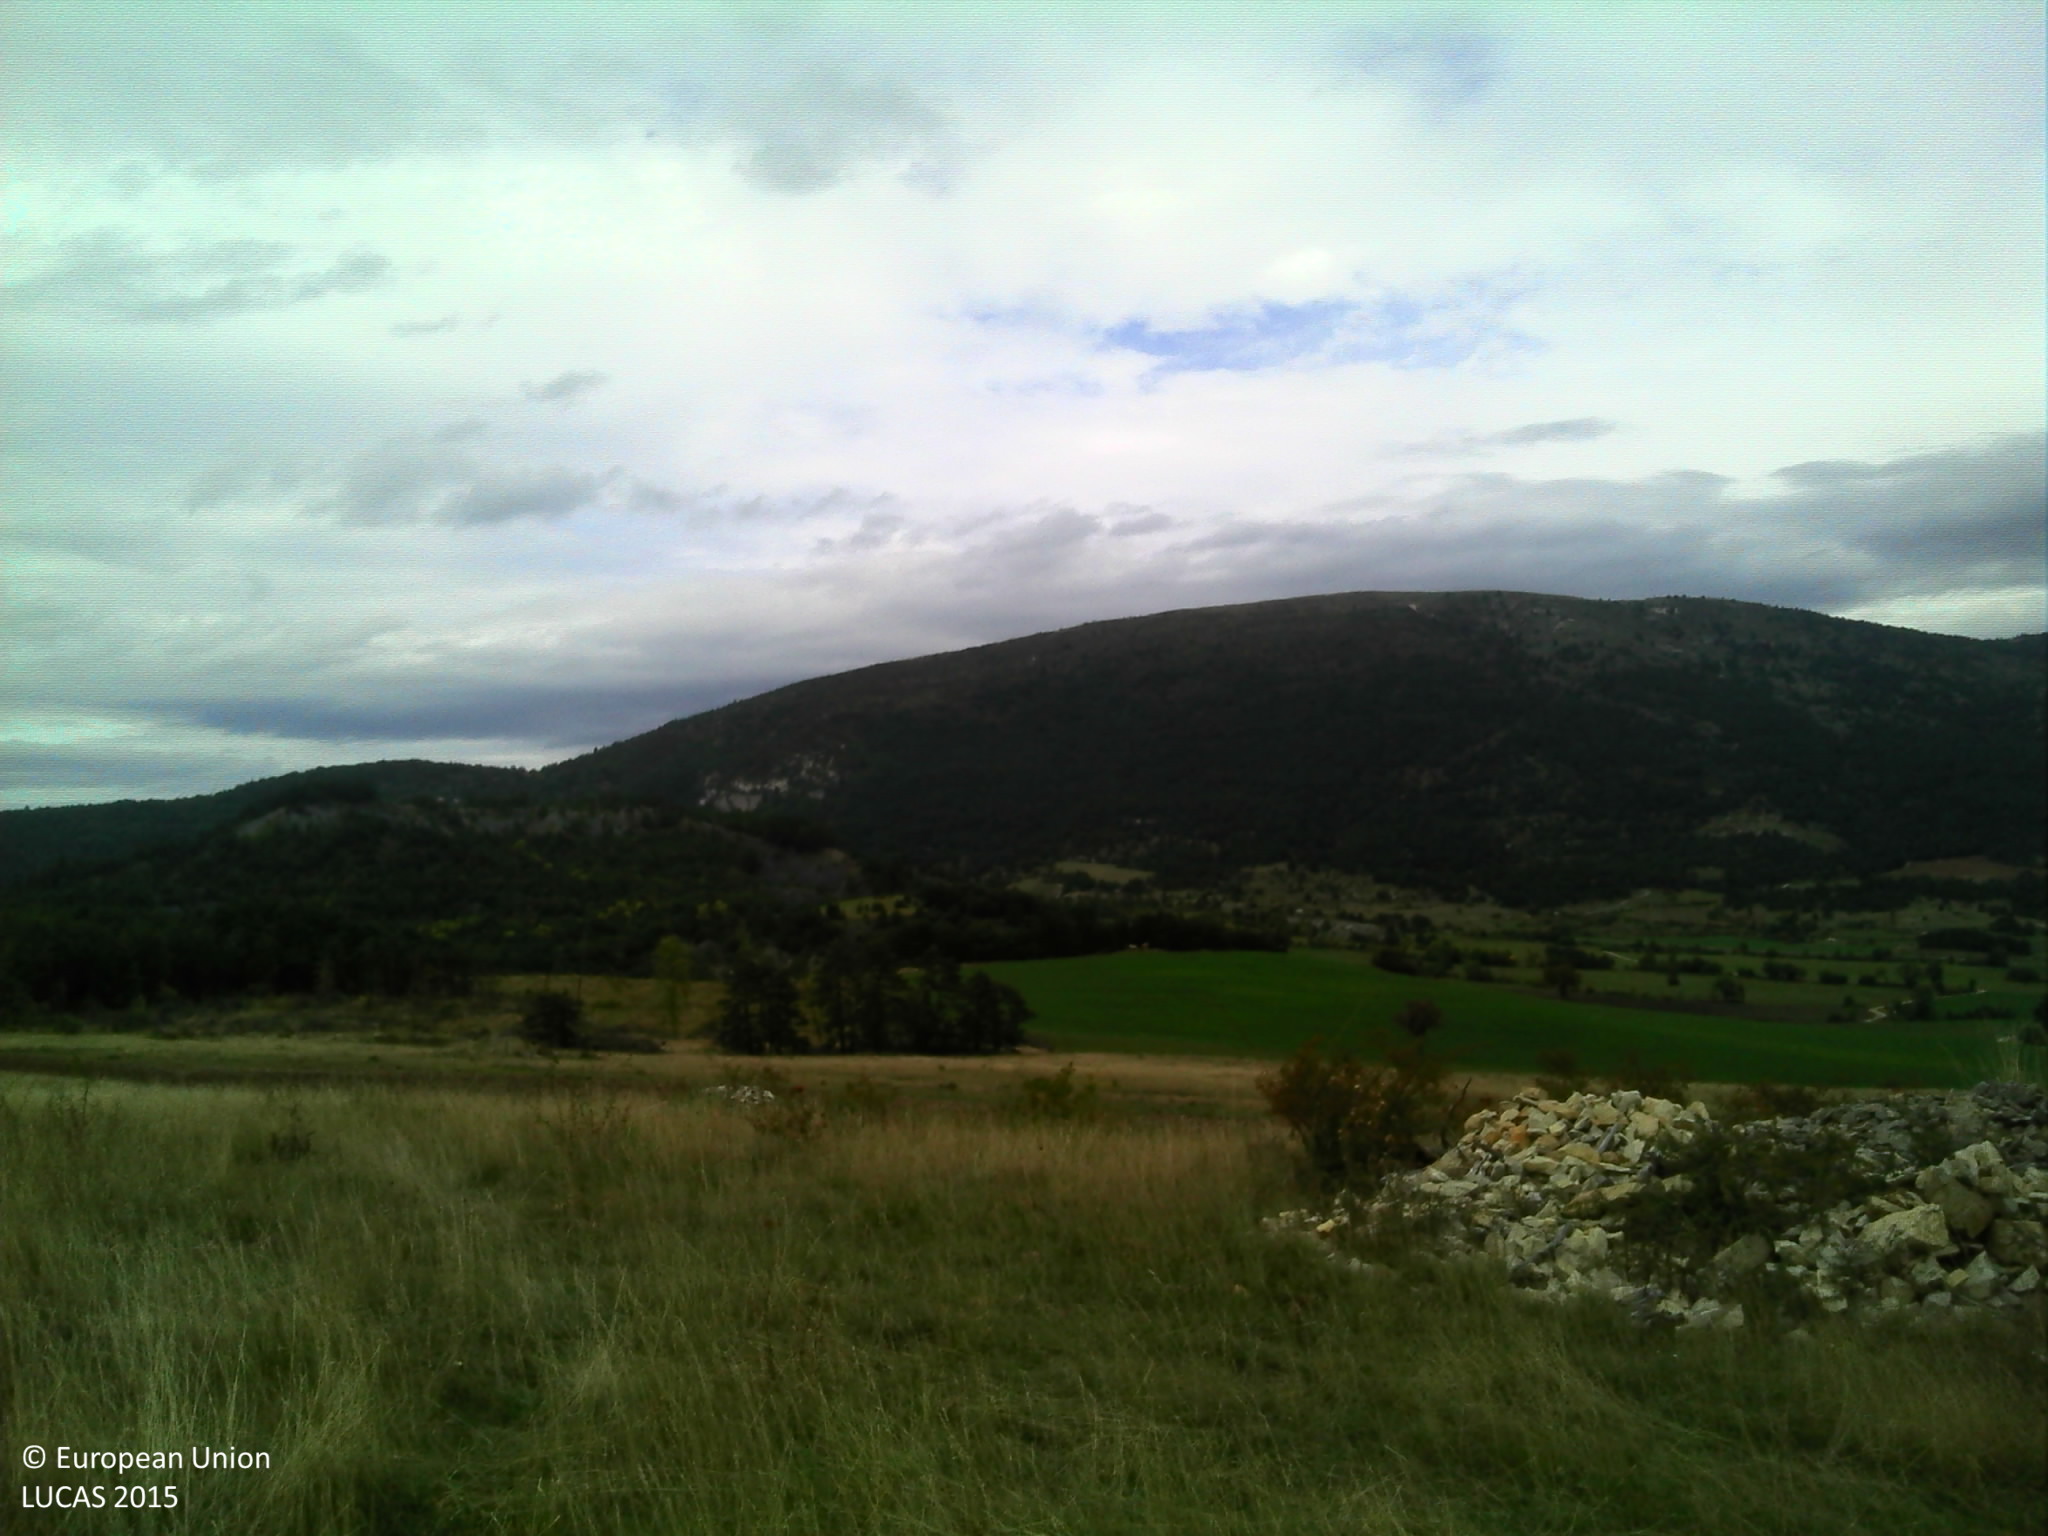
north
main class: Grassland
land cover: Grassland without tree/shrub cover
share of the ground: > 75 %
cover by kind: herbaceous plants 100 %
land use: Agriculture (excluding fallow land and kitchen gardens)
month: September
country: FR
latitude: 44.5796
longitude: 5.5359
